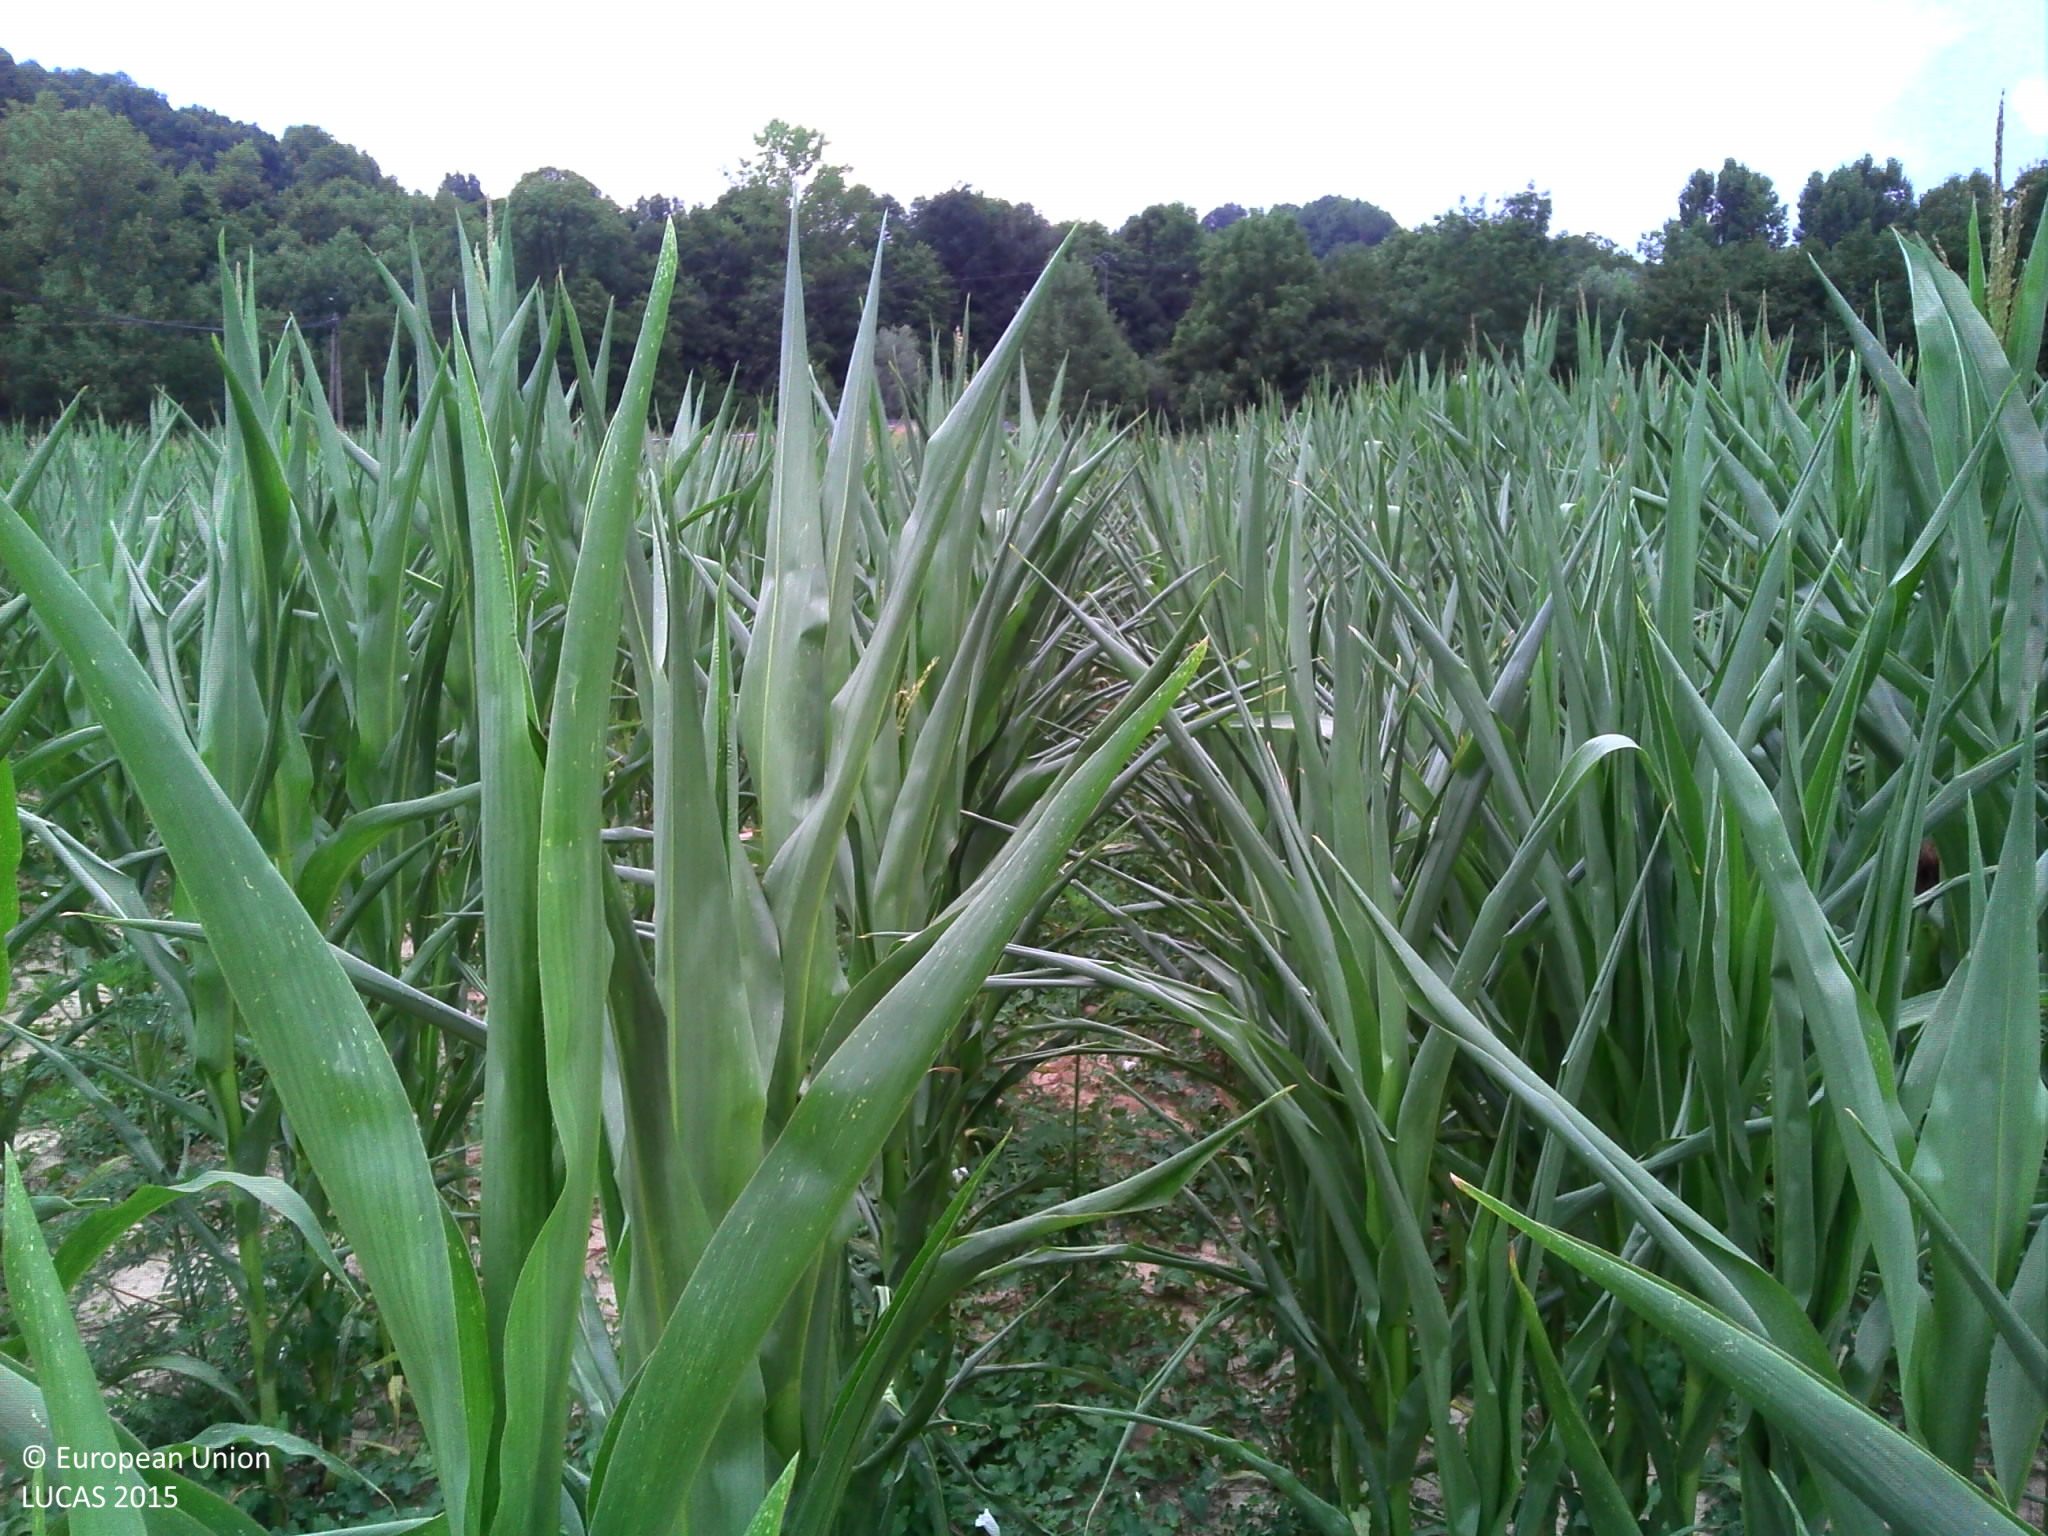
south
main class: Cropland
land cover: Maize
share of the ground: > 75 %
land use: Agriculture (excluding fallow land and kitchen gardens)
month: July
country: FR
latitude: 45.4392
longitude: 4.9804
